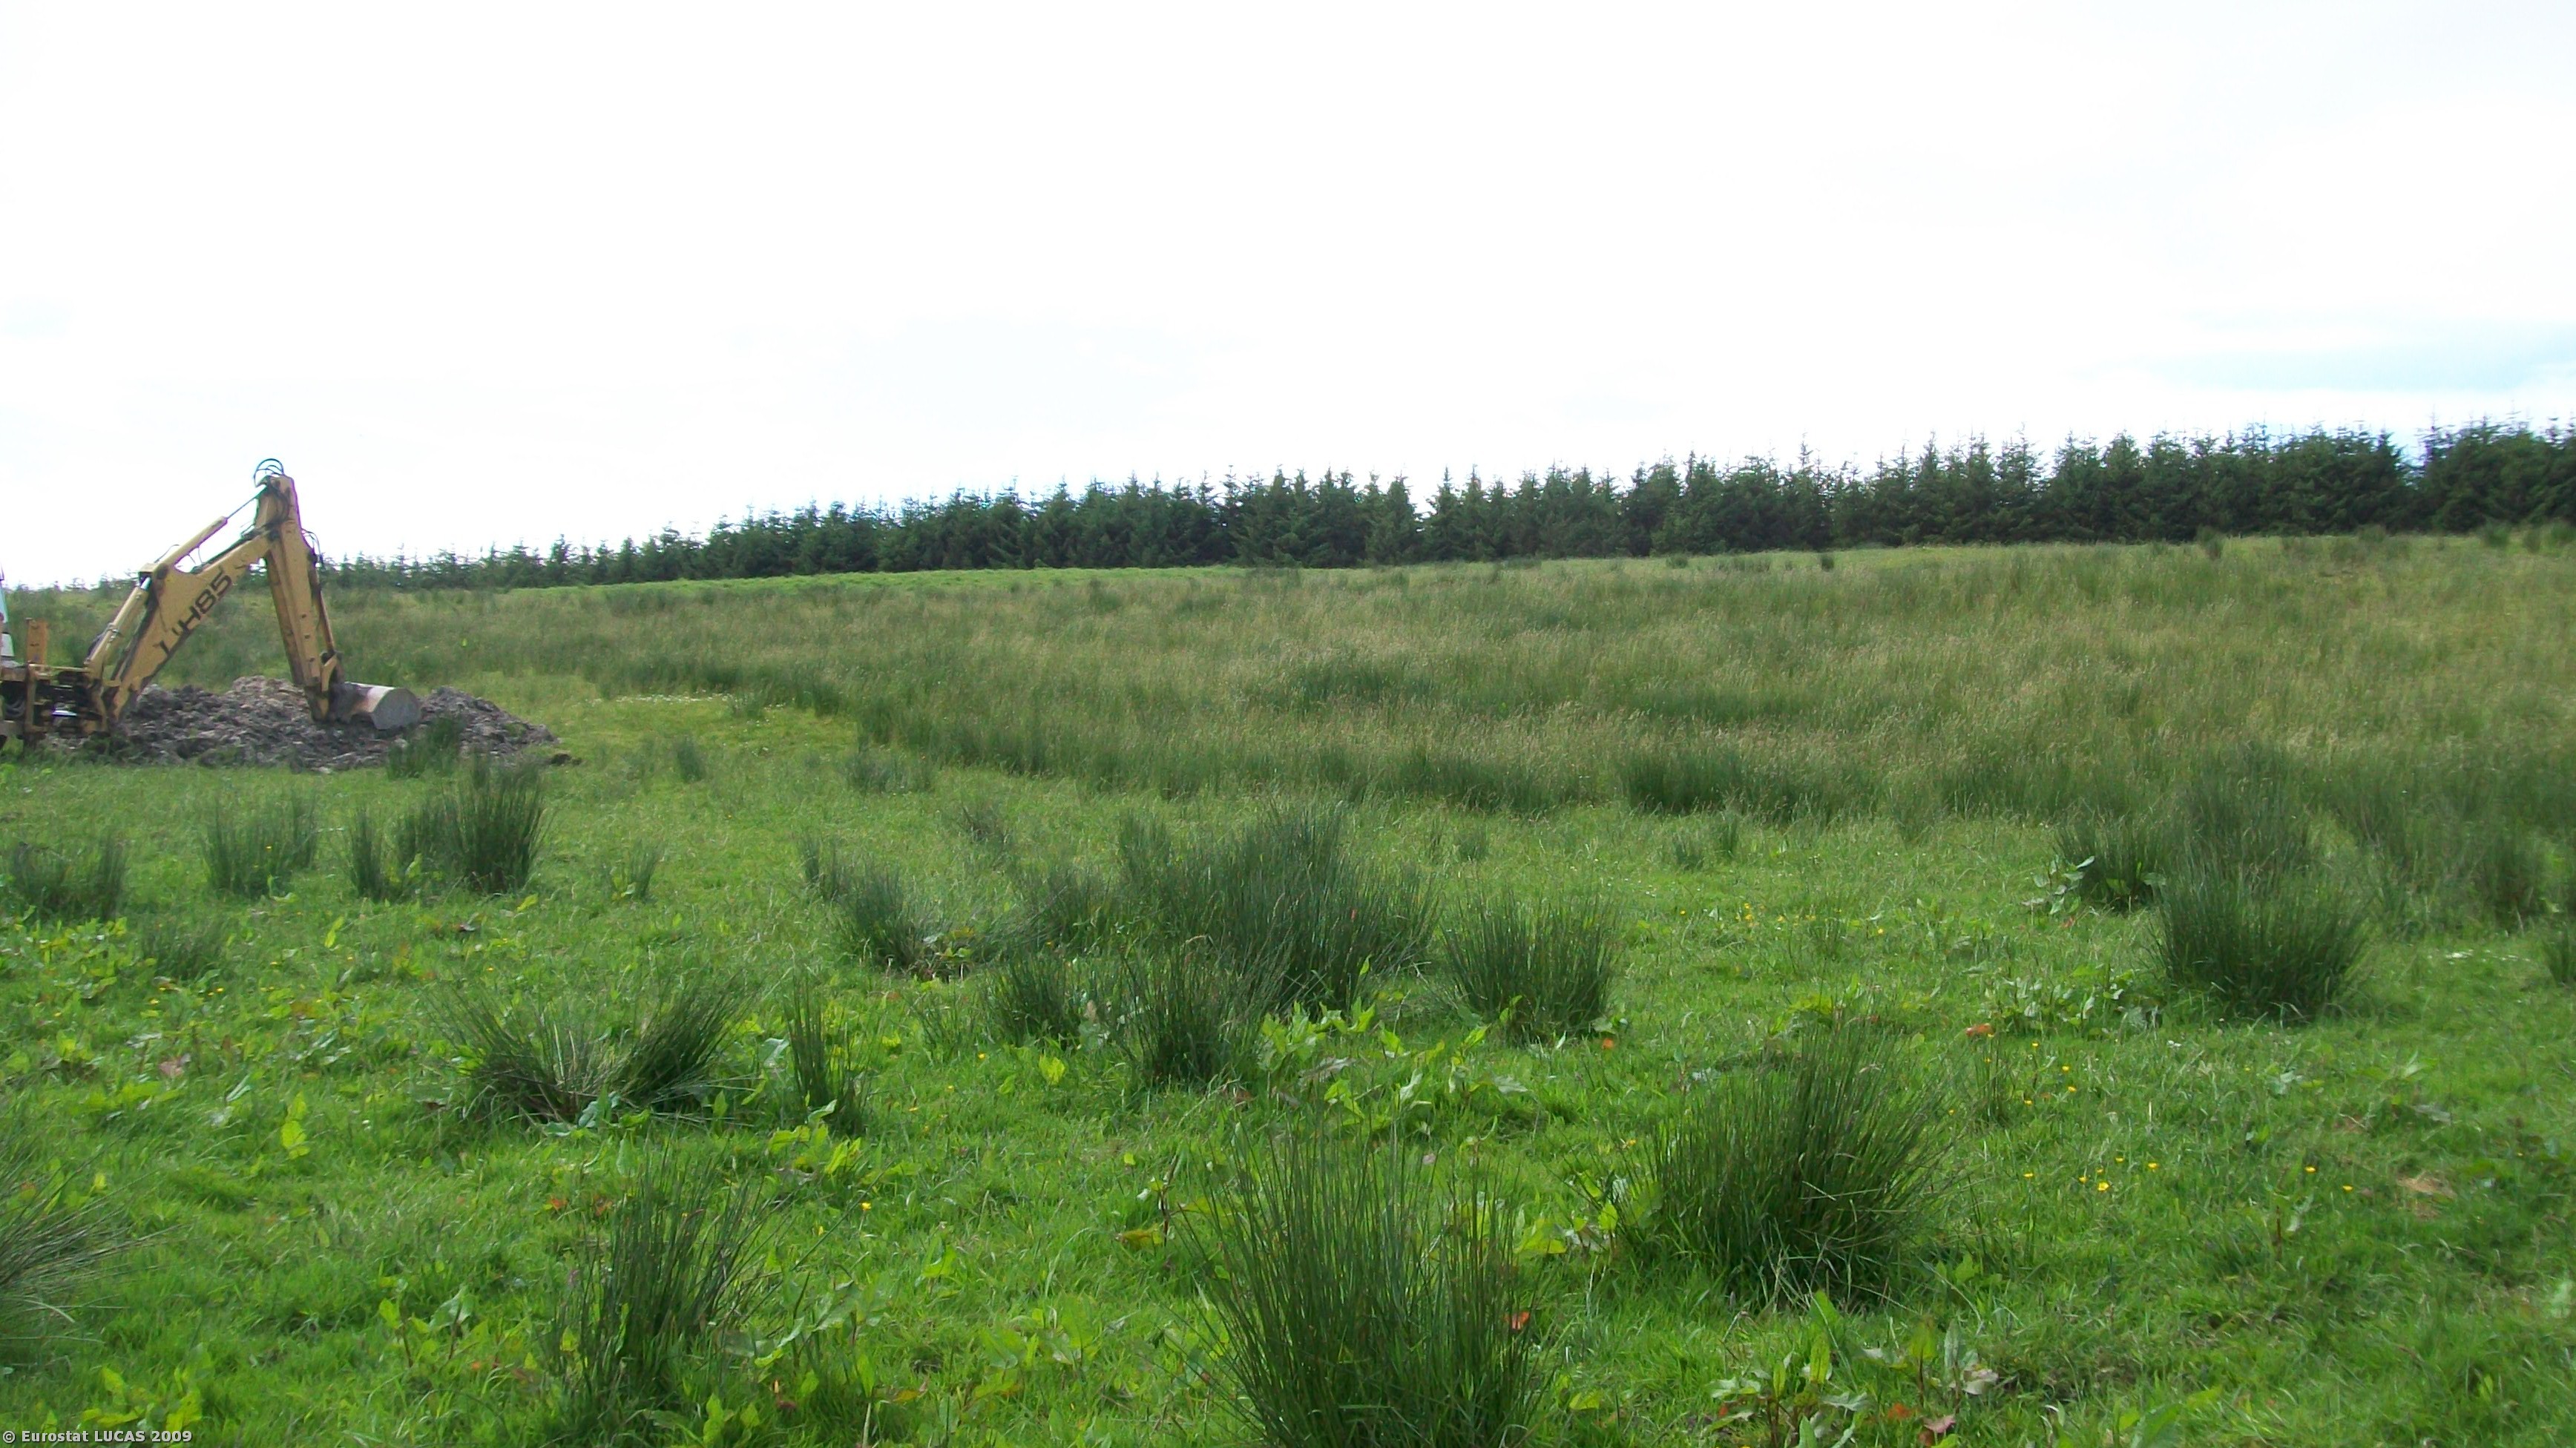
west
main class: Grassland
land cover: Grassland without tree/shrub cover
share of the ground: > 75 %
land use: Agriculture (excluding fallow land and kitchen gardens)
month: June
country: GB
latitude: 57.5985
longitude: -2.8584
